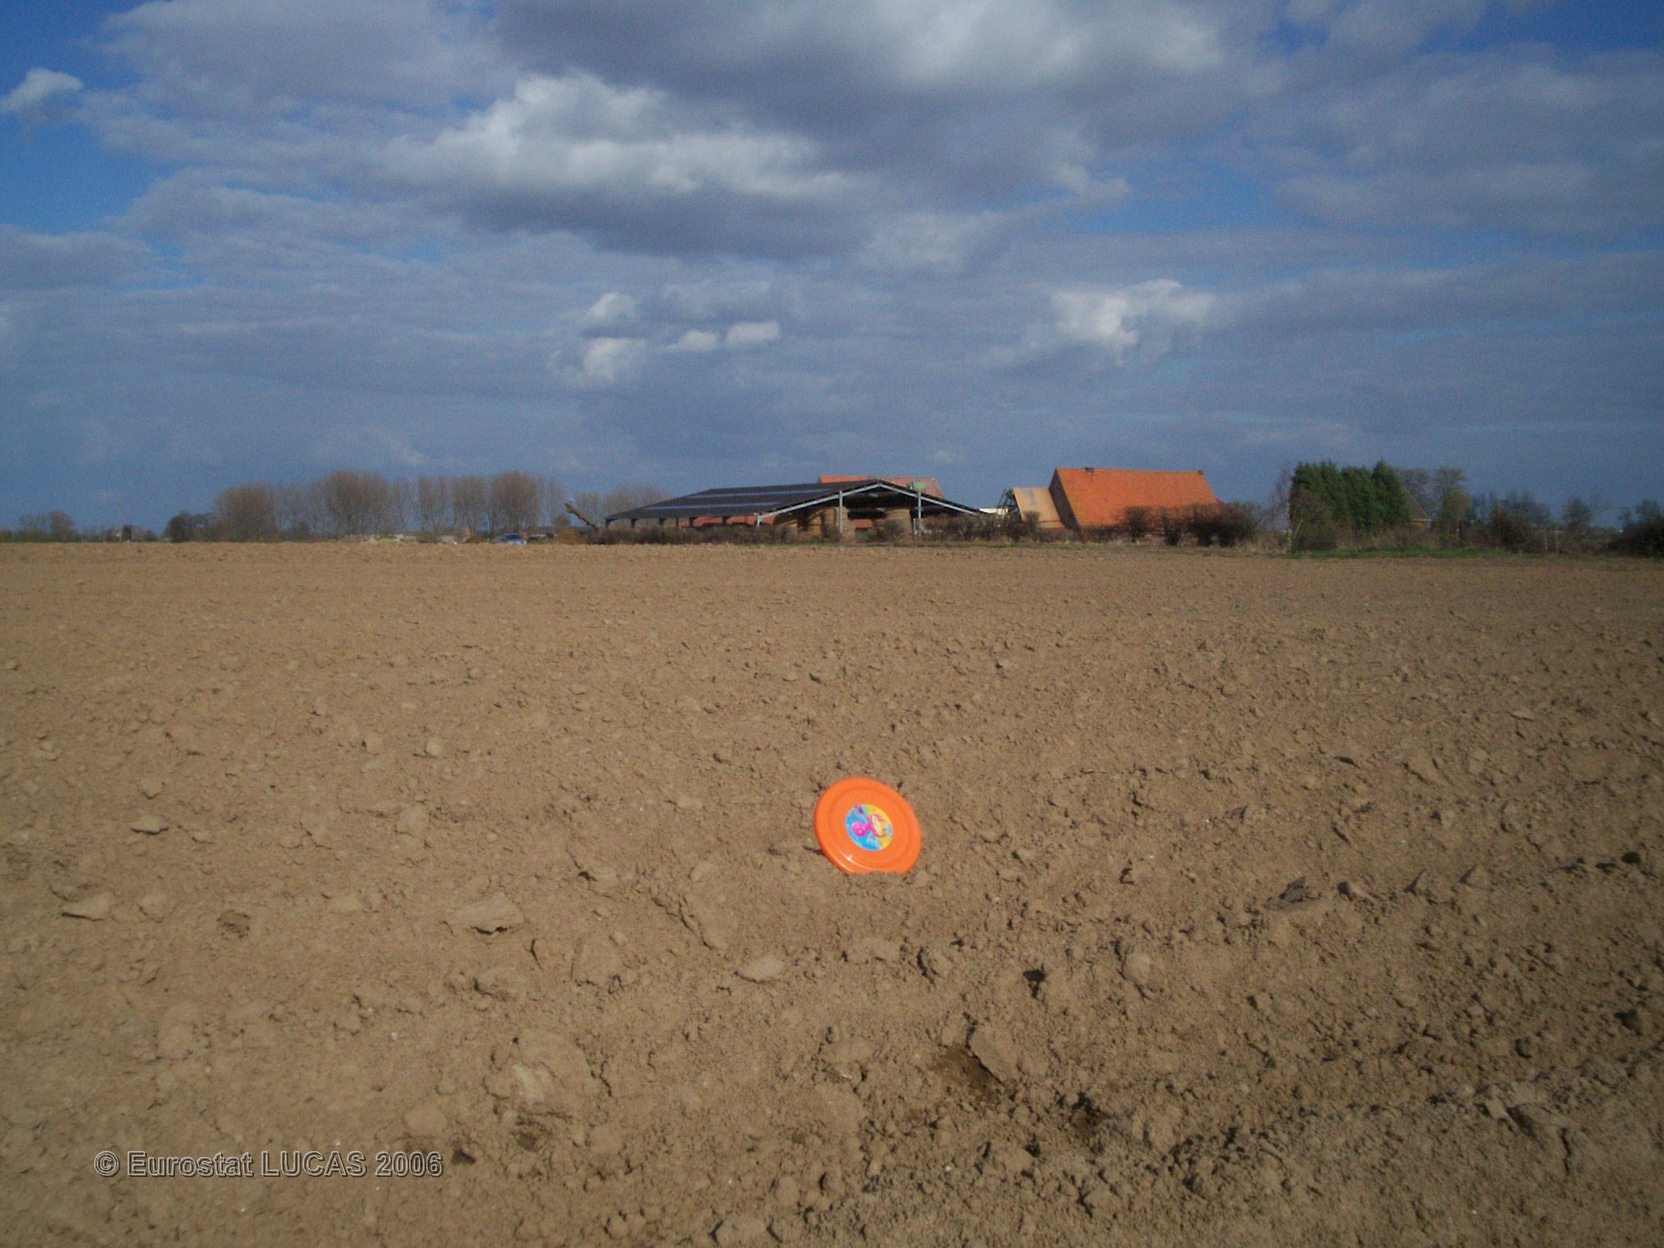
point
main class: Cropland
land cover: Potatoes
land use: Agriculture (excluding fallow land and kitchen gardens)
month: May
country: FR
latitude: 50.8920
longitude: 2.4664
